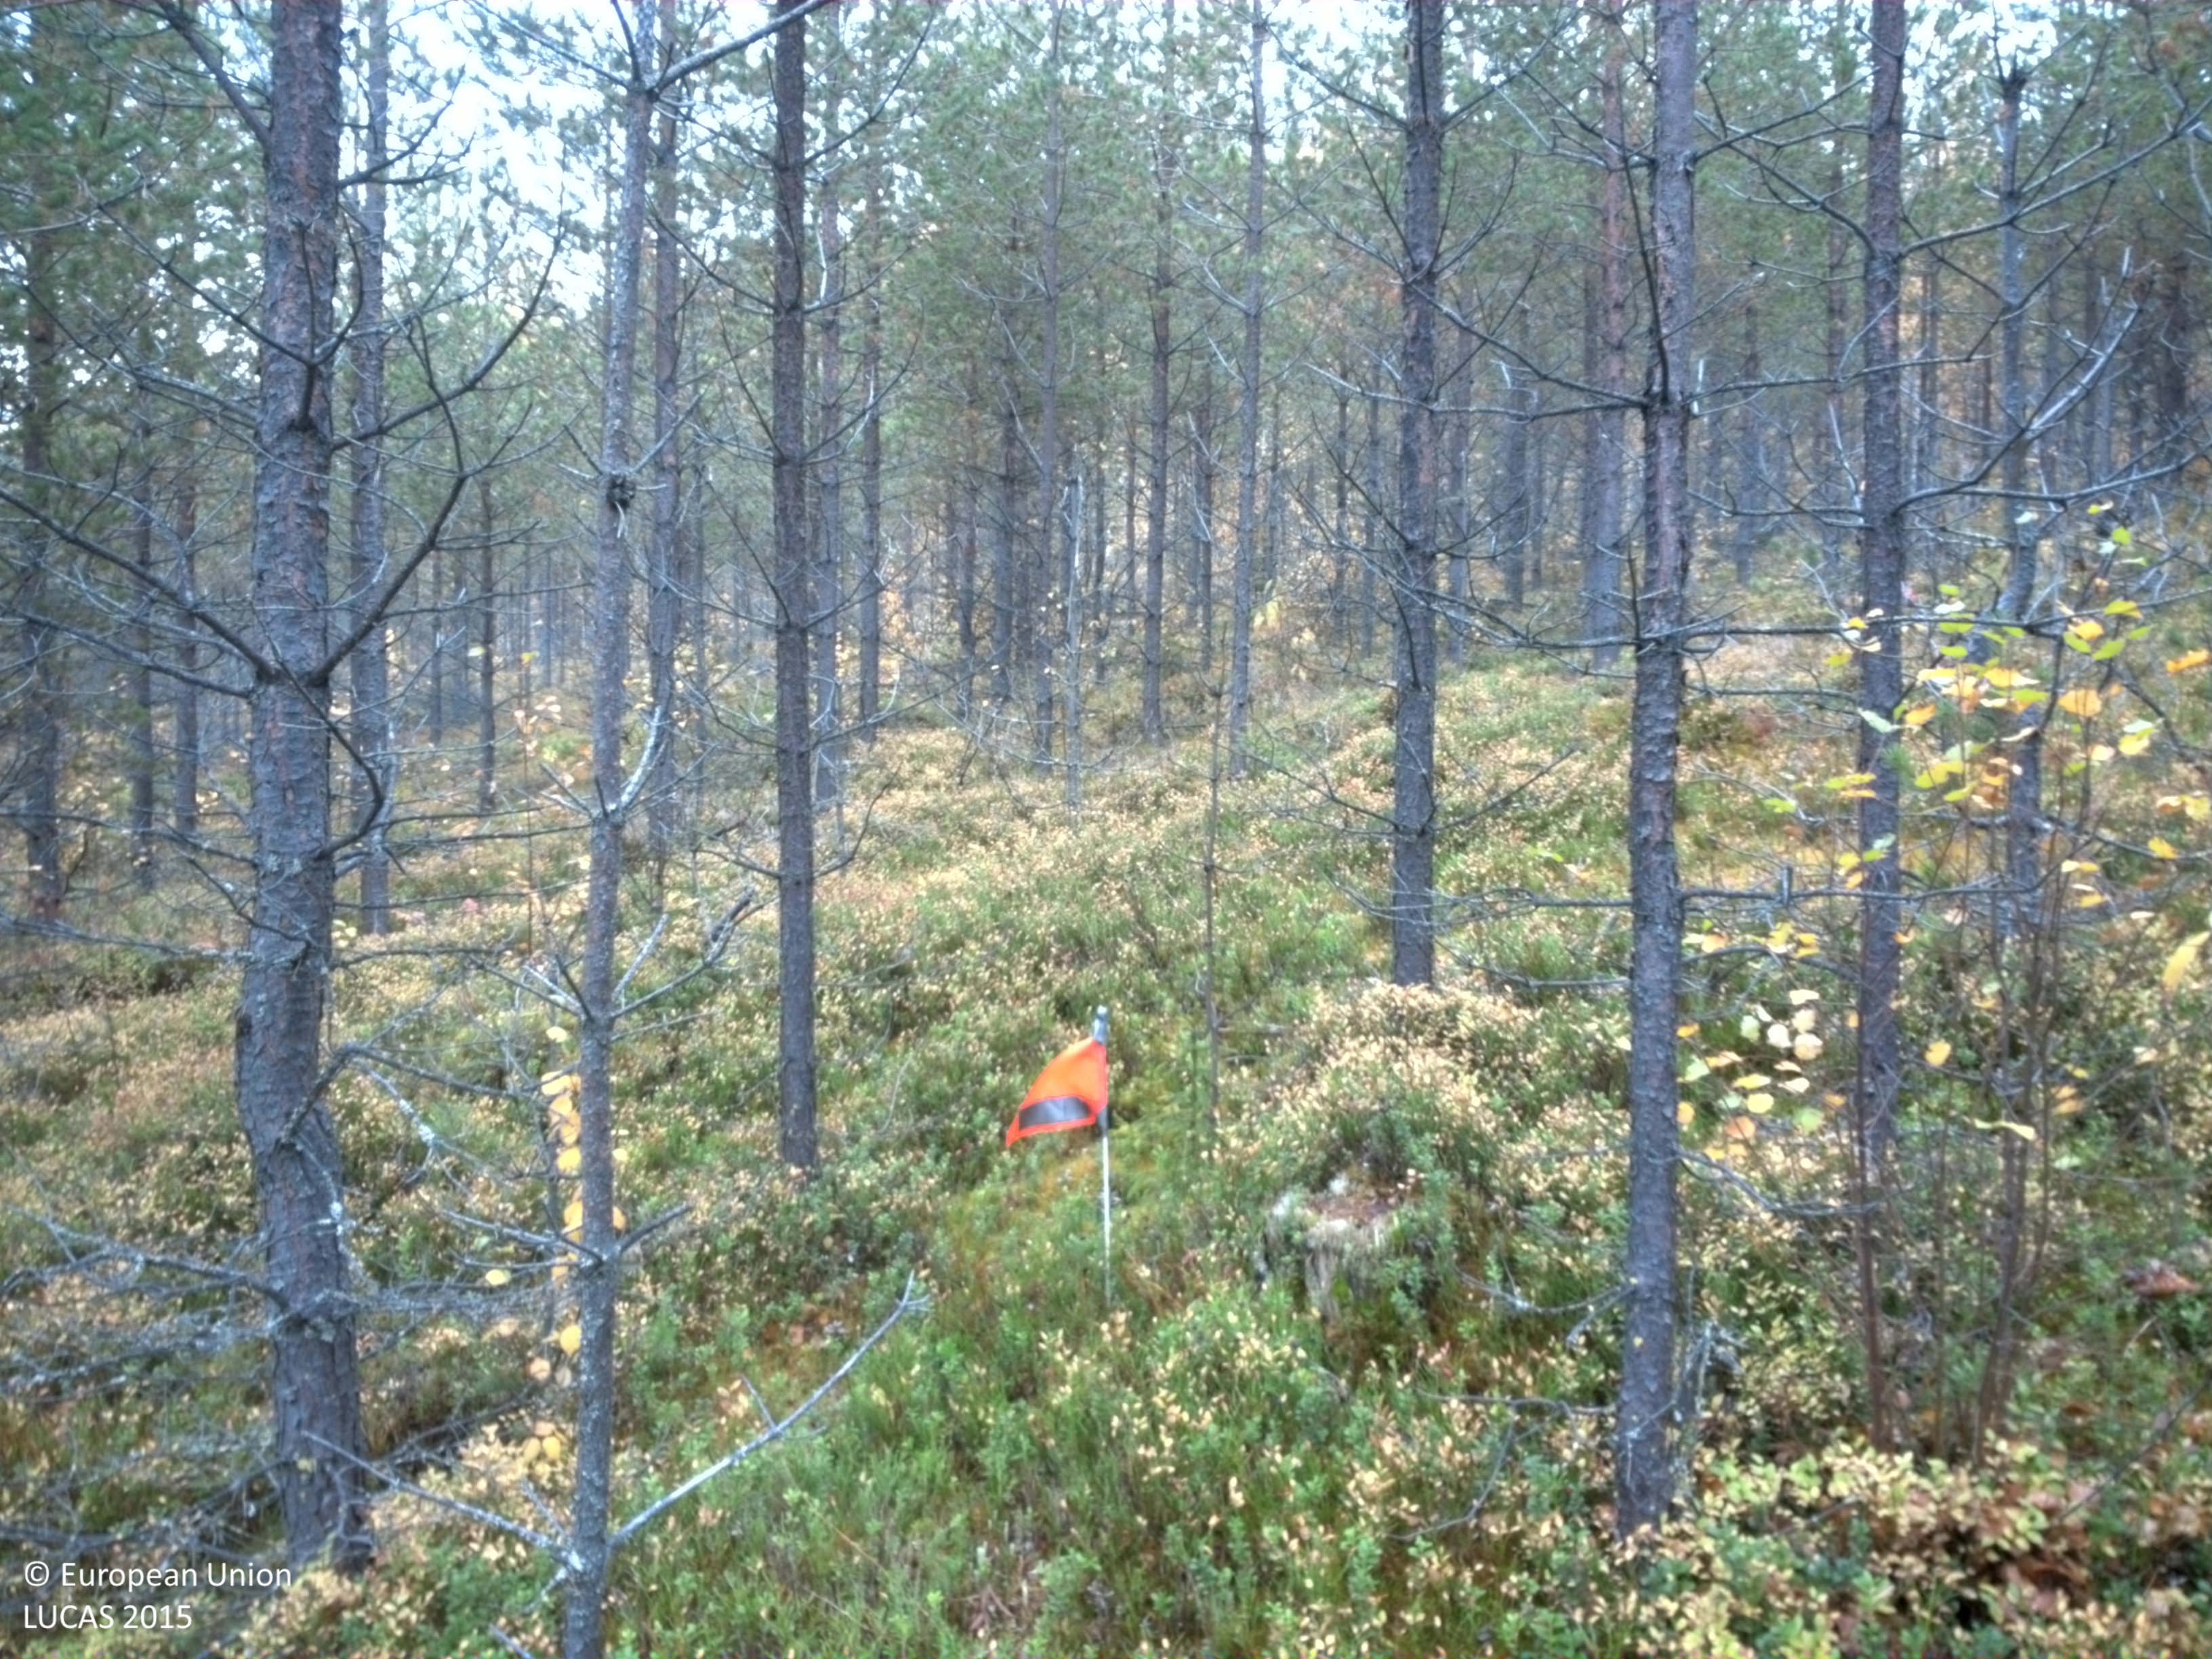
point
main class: Woodland
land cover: Pine dominated coniferous woodland
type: boreal forest
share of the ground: 25 - 50 %
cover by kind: coniferous forest trees 40 %, shrubs 40 %, lichens and mosses 15 %, broadleaved forest trees 5 %
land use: Forestry
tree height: > 5 m
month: September
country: SE
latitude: 64.8984
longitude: 17.7600
